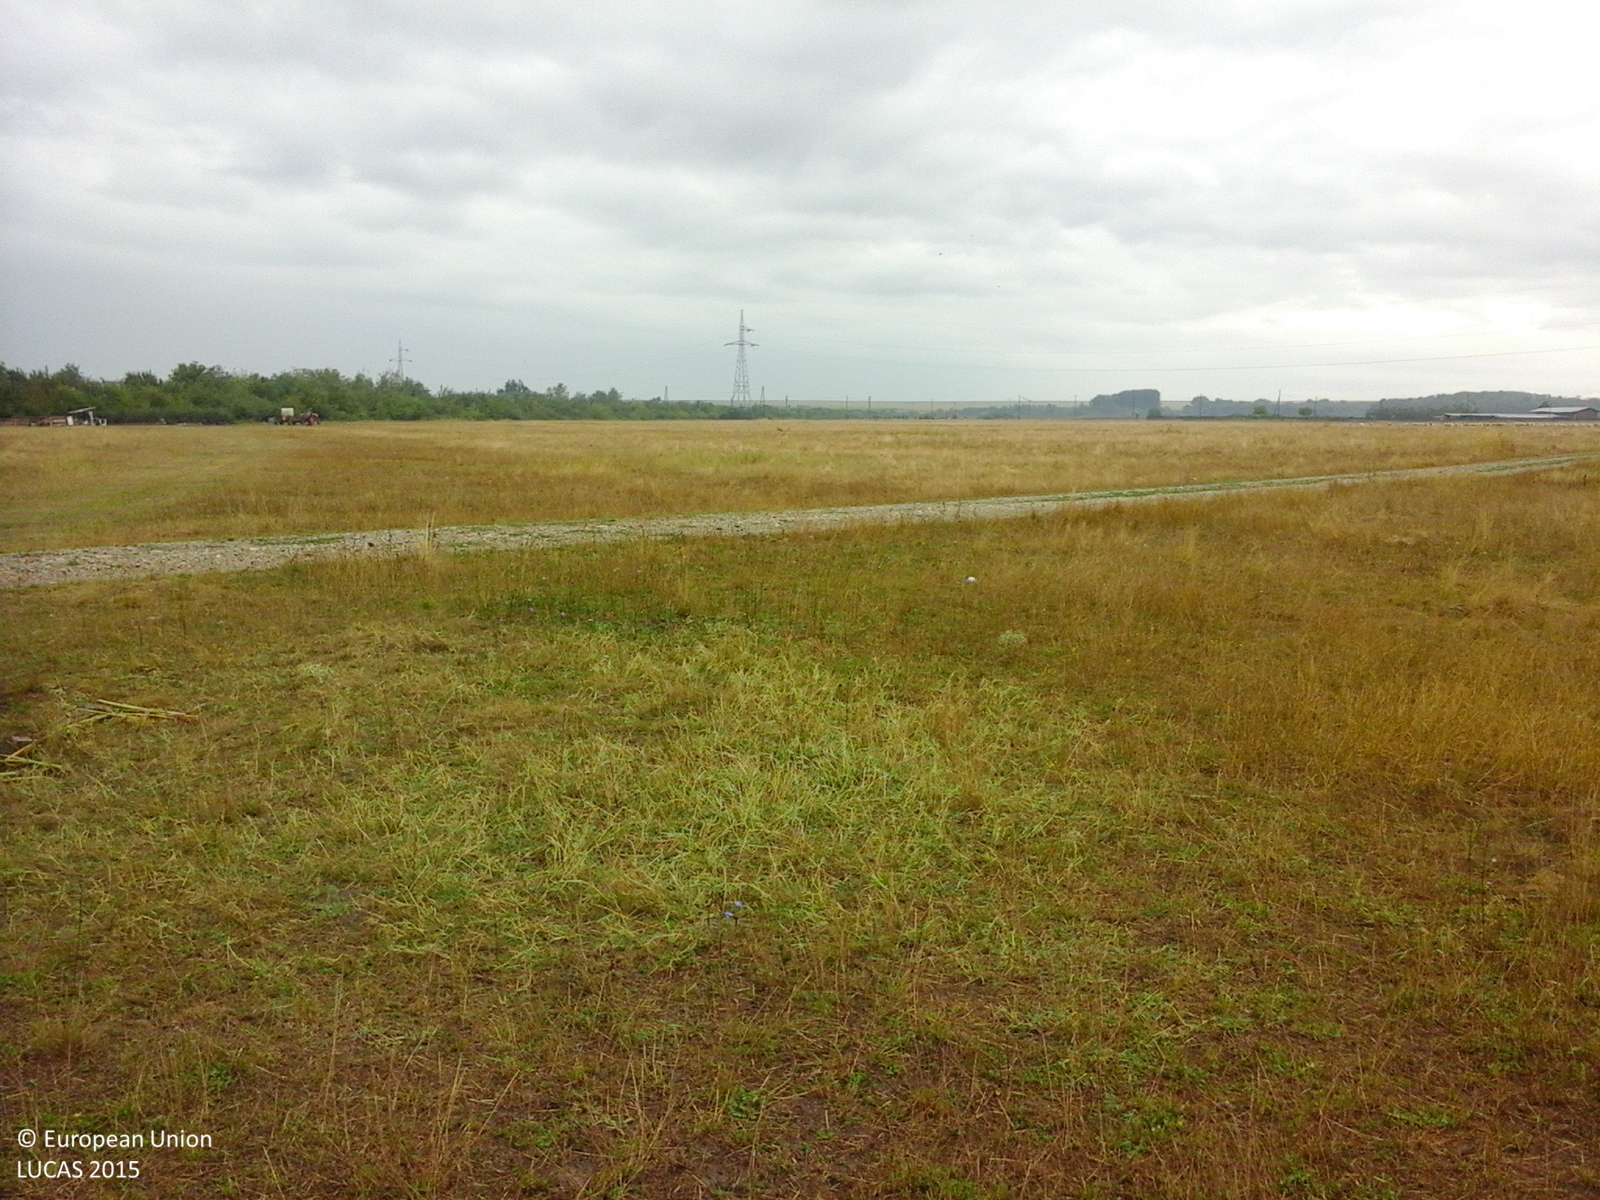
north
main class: Grassland
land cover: Grassland without tree/shrub cover
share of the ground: > 75 %
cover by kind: herbaceous plants 100 %
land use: Agriculture (excluding fallow land and kitchen gardens)
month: August
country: RO
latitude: 45.4256
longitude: 21.4444
